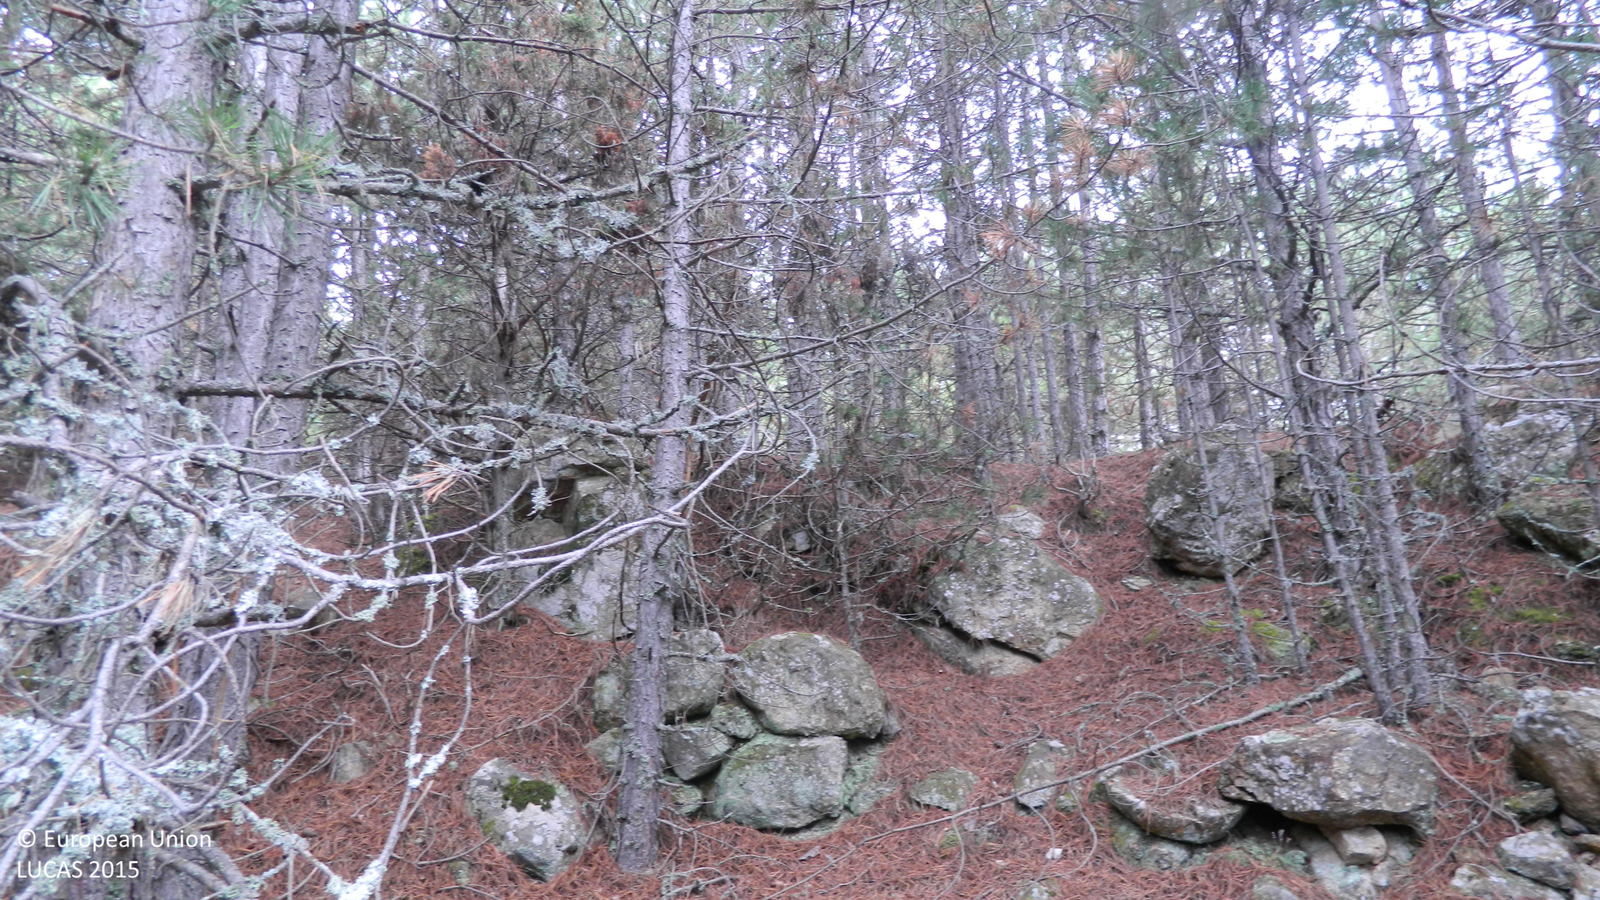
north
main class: Woodland
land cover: Pine dominated coniferous woodland
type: hemiboreal forest and nemoral coniferous forest and mixed broadleaved-coniferous forest
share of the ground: > 75 %
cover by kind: coniferous forest trees 80 %, herbaceous plants 10 %, unconsolidated bare surface 10 %
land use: Forestry
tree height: > 5 m
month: September
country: BG
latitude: 41.5239
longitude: 24.0415
